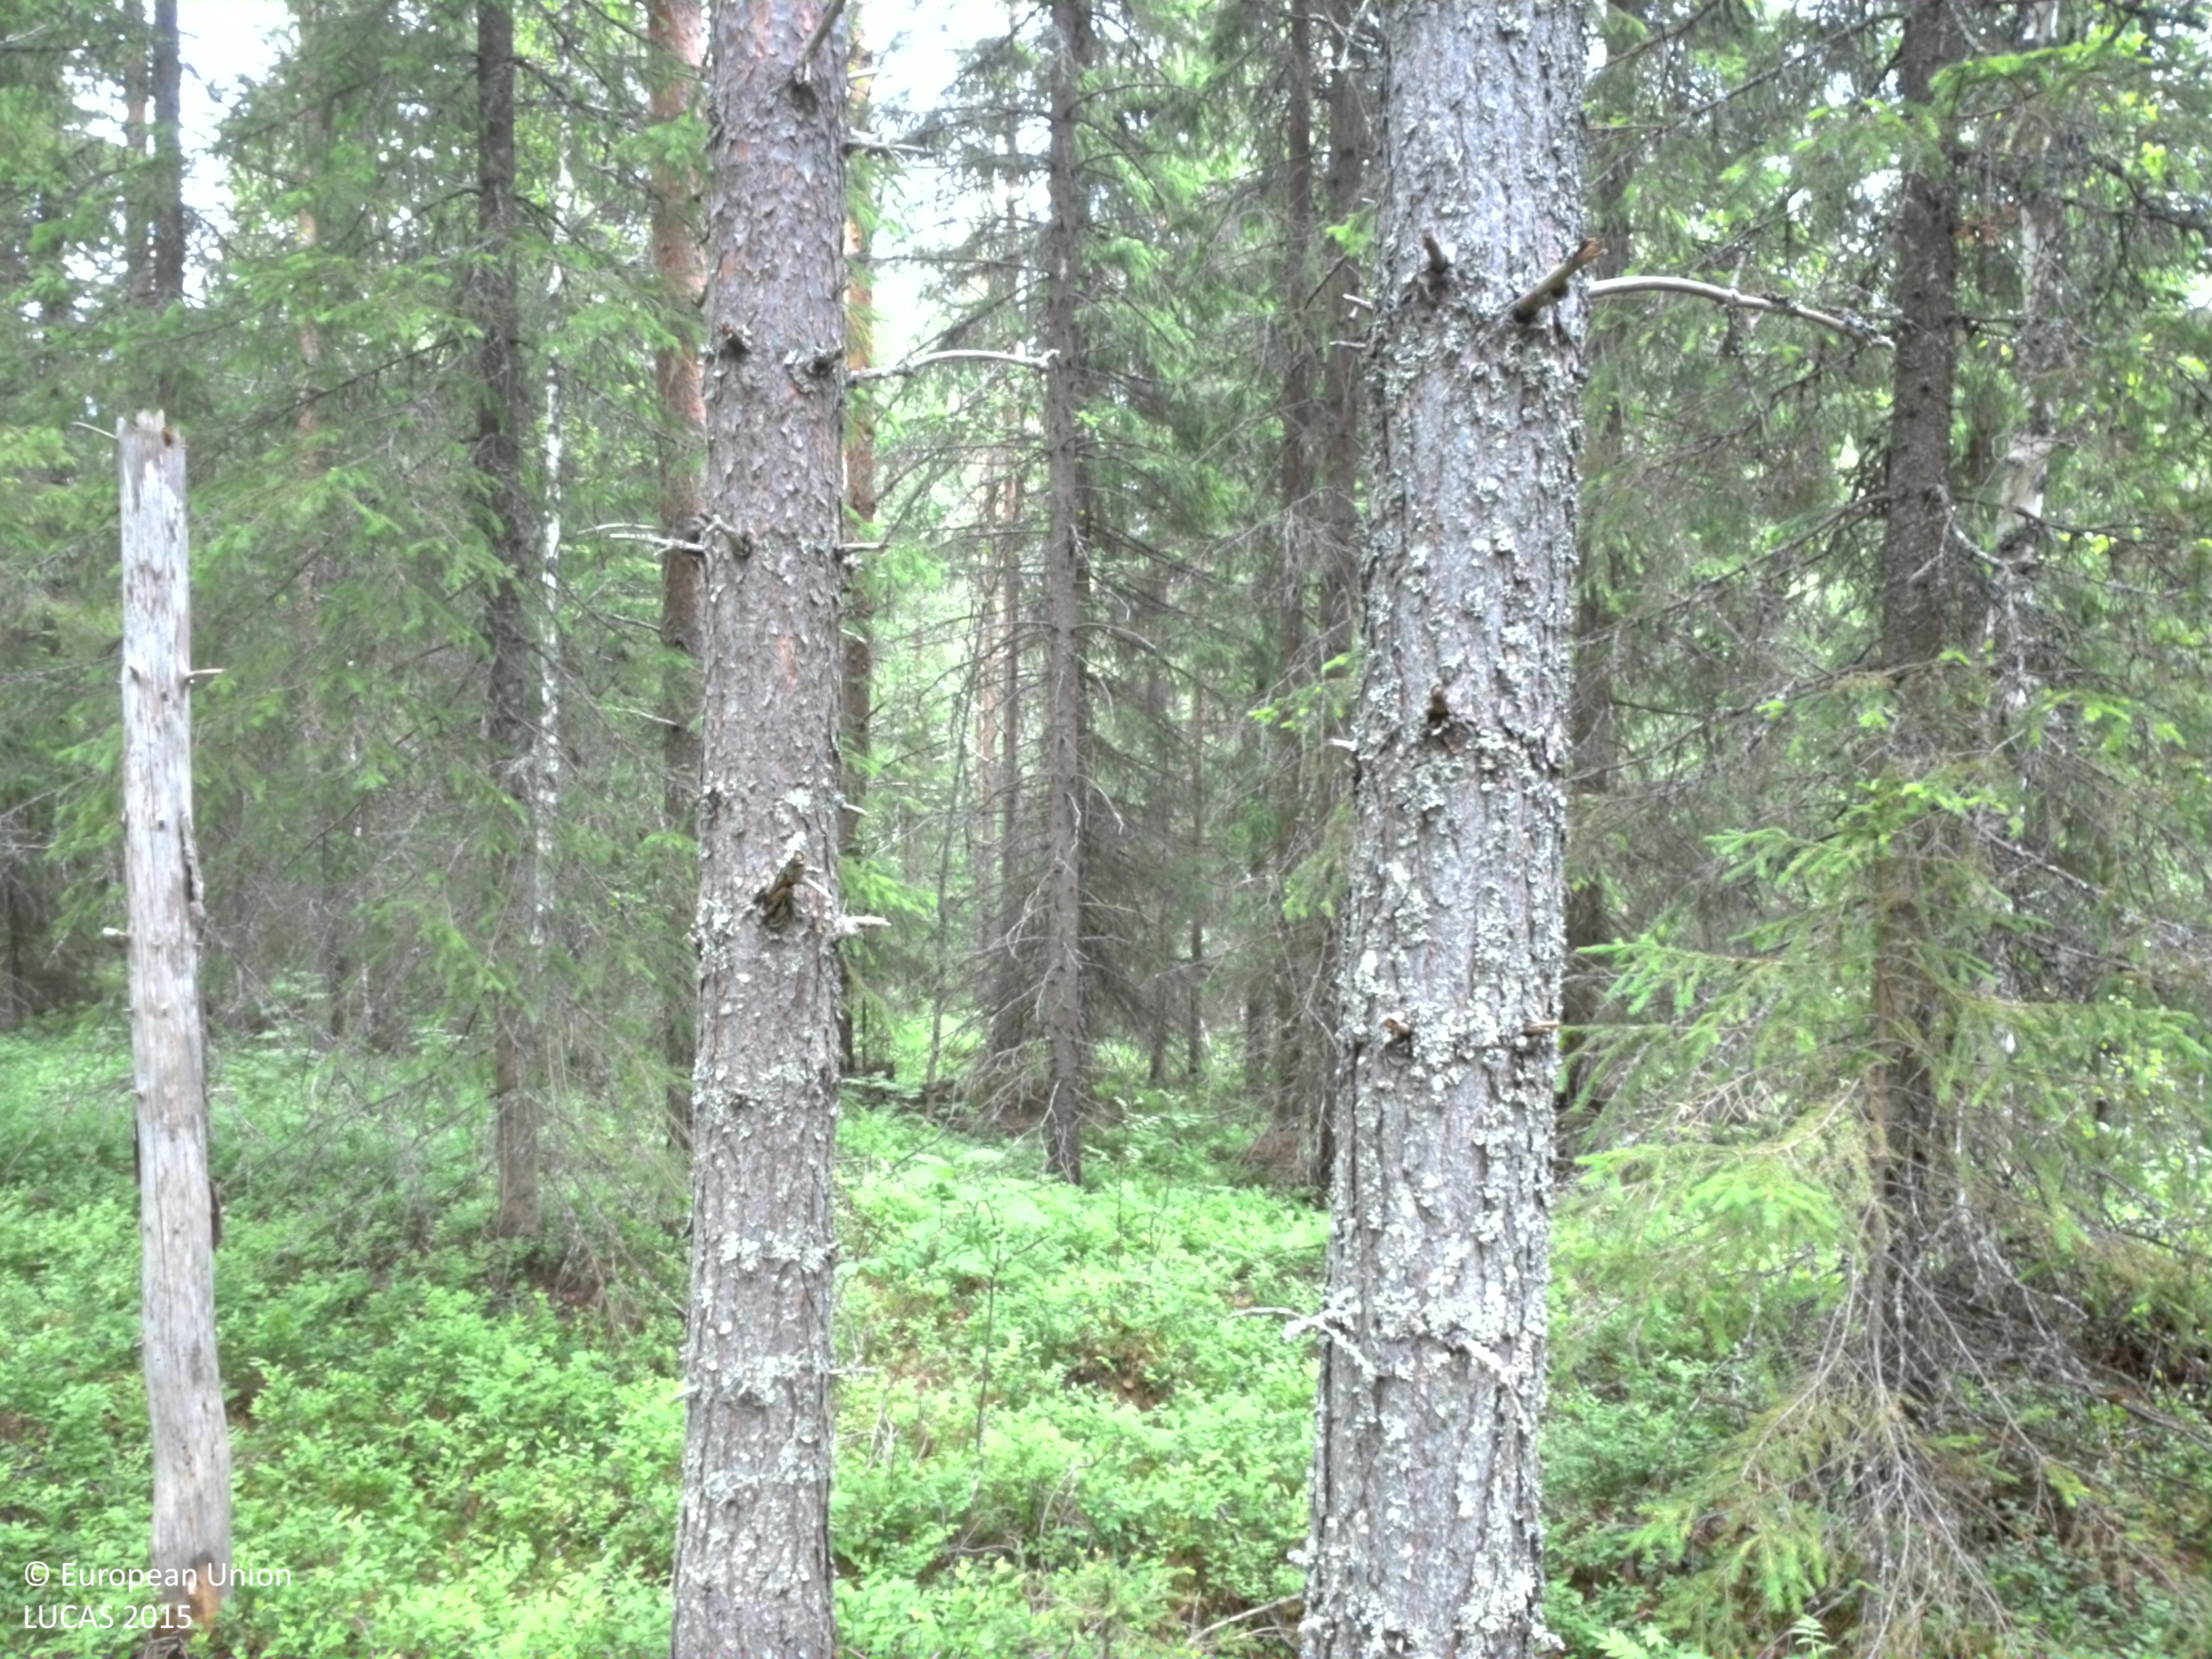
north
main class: Woodland
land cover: Other coniferous woodland
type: boreal forest
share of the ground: 50 - 75 %
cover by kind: coniferous forest trees 65 %, shrubs 25 %, broadleaved forest trees 10 %
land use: Forestry
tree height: > 5 m
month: July
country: SE
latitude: 64.4512
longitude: 20.7651
